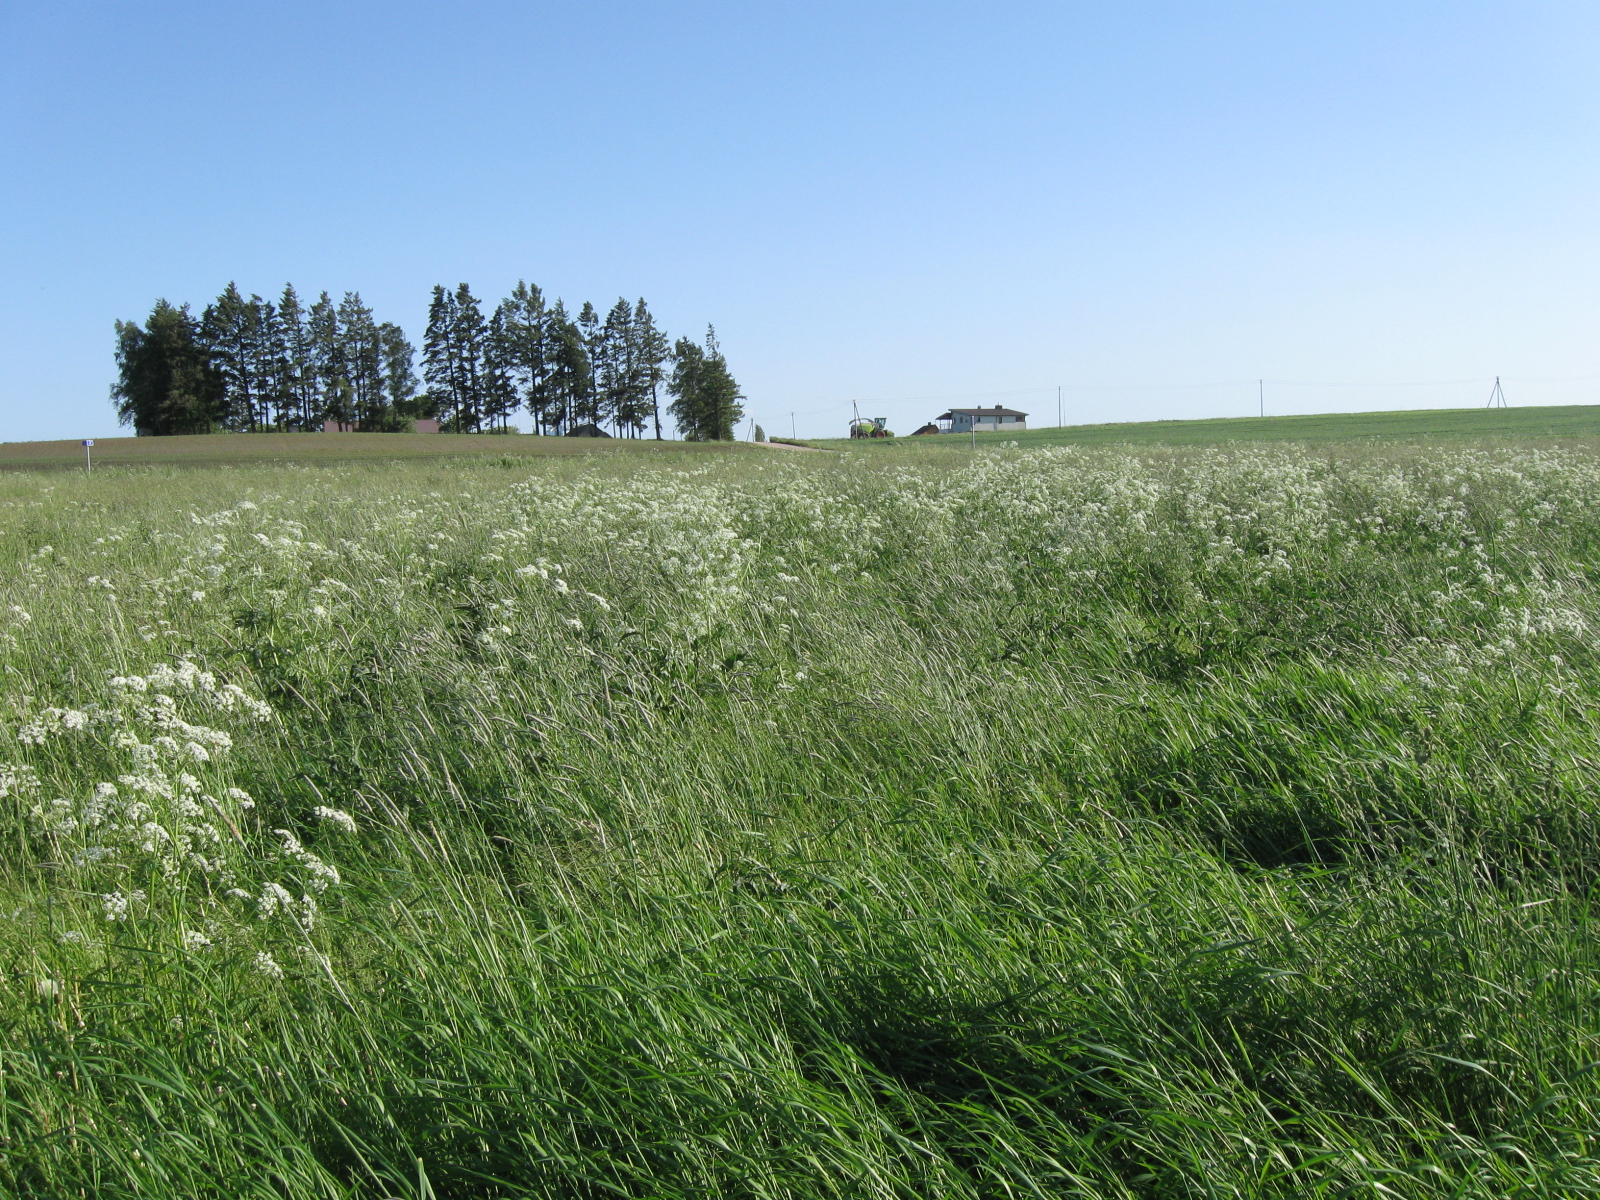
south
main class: Cropland
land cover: Rape and turnip rape
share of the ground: > 75 %
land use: Agriculture (excluding fallow land and kitchen gardens)
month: June
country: LT
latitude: 54.4333
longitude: 23.7930
